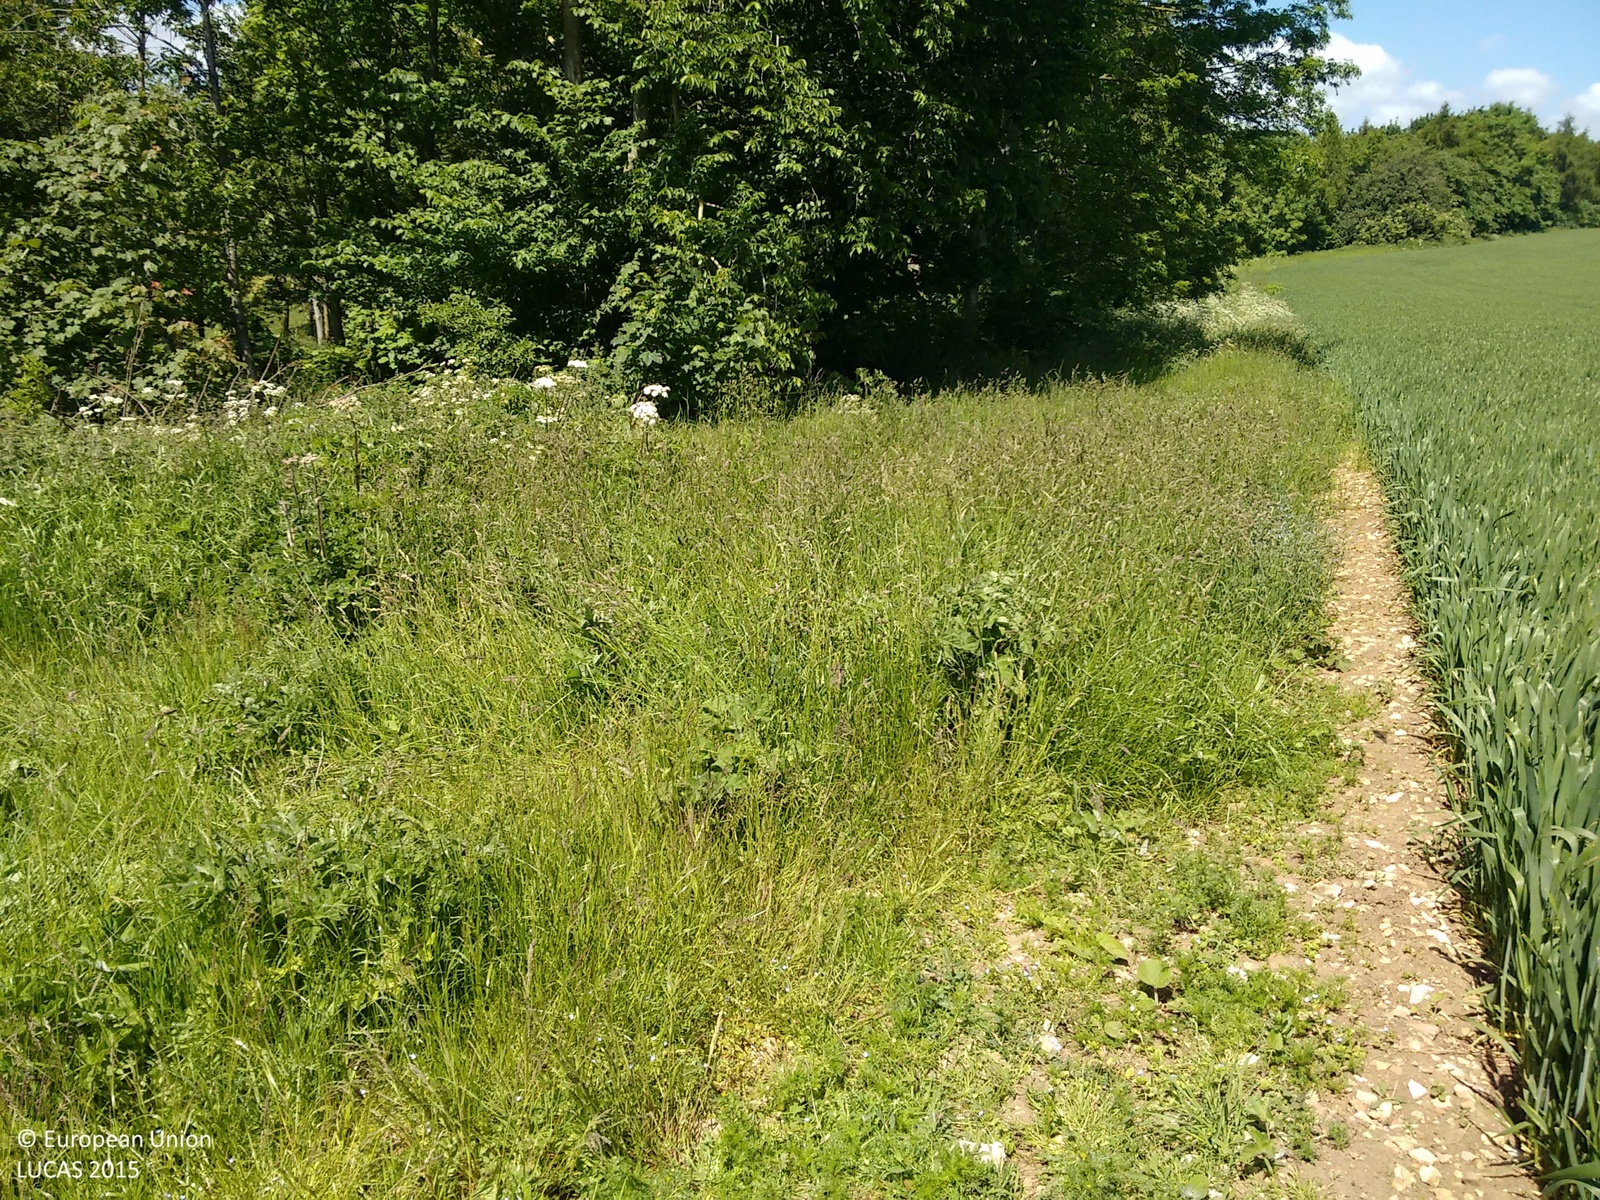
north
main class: Cropland
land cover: Barley
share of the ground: > 75 %
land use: Agriculture (excluding fallow land and kitchen gardens)
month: June
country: GB
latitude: 54.1880
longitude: -1.5899
